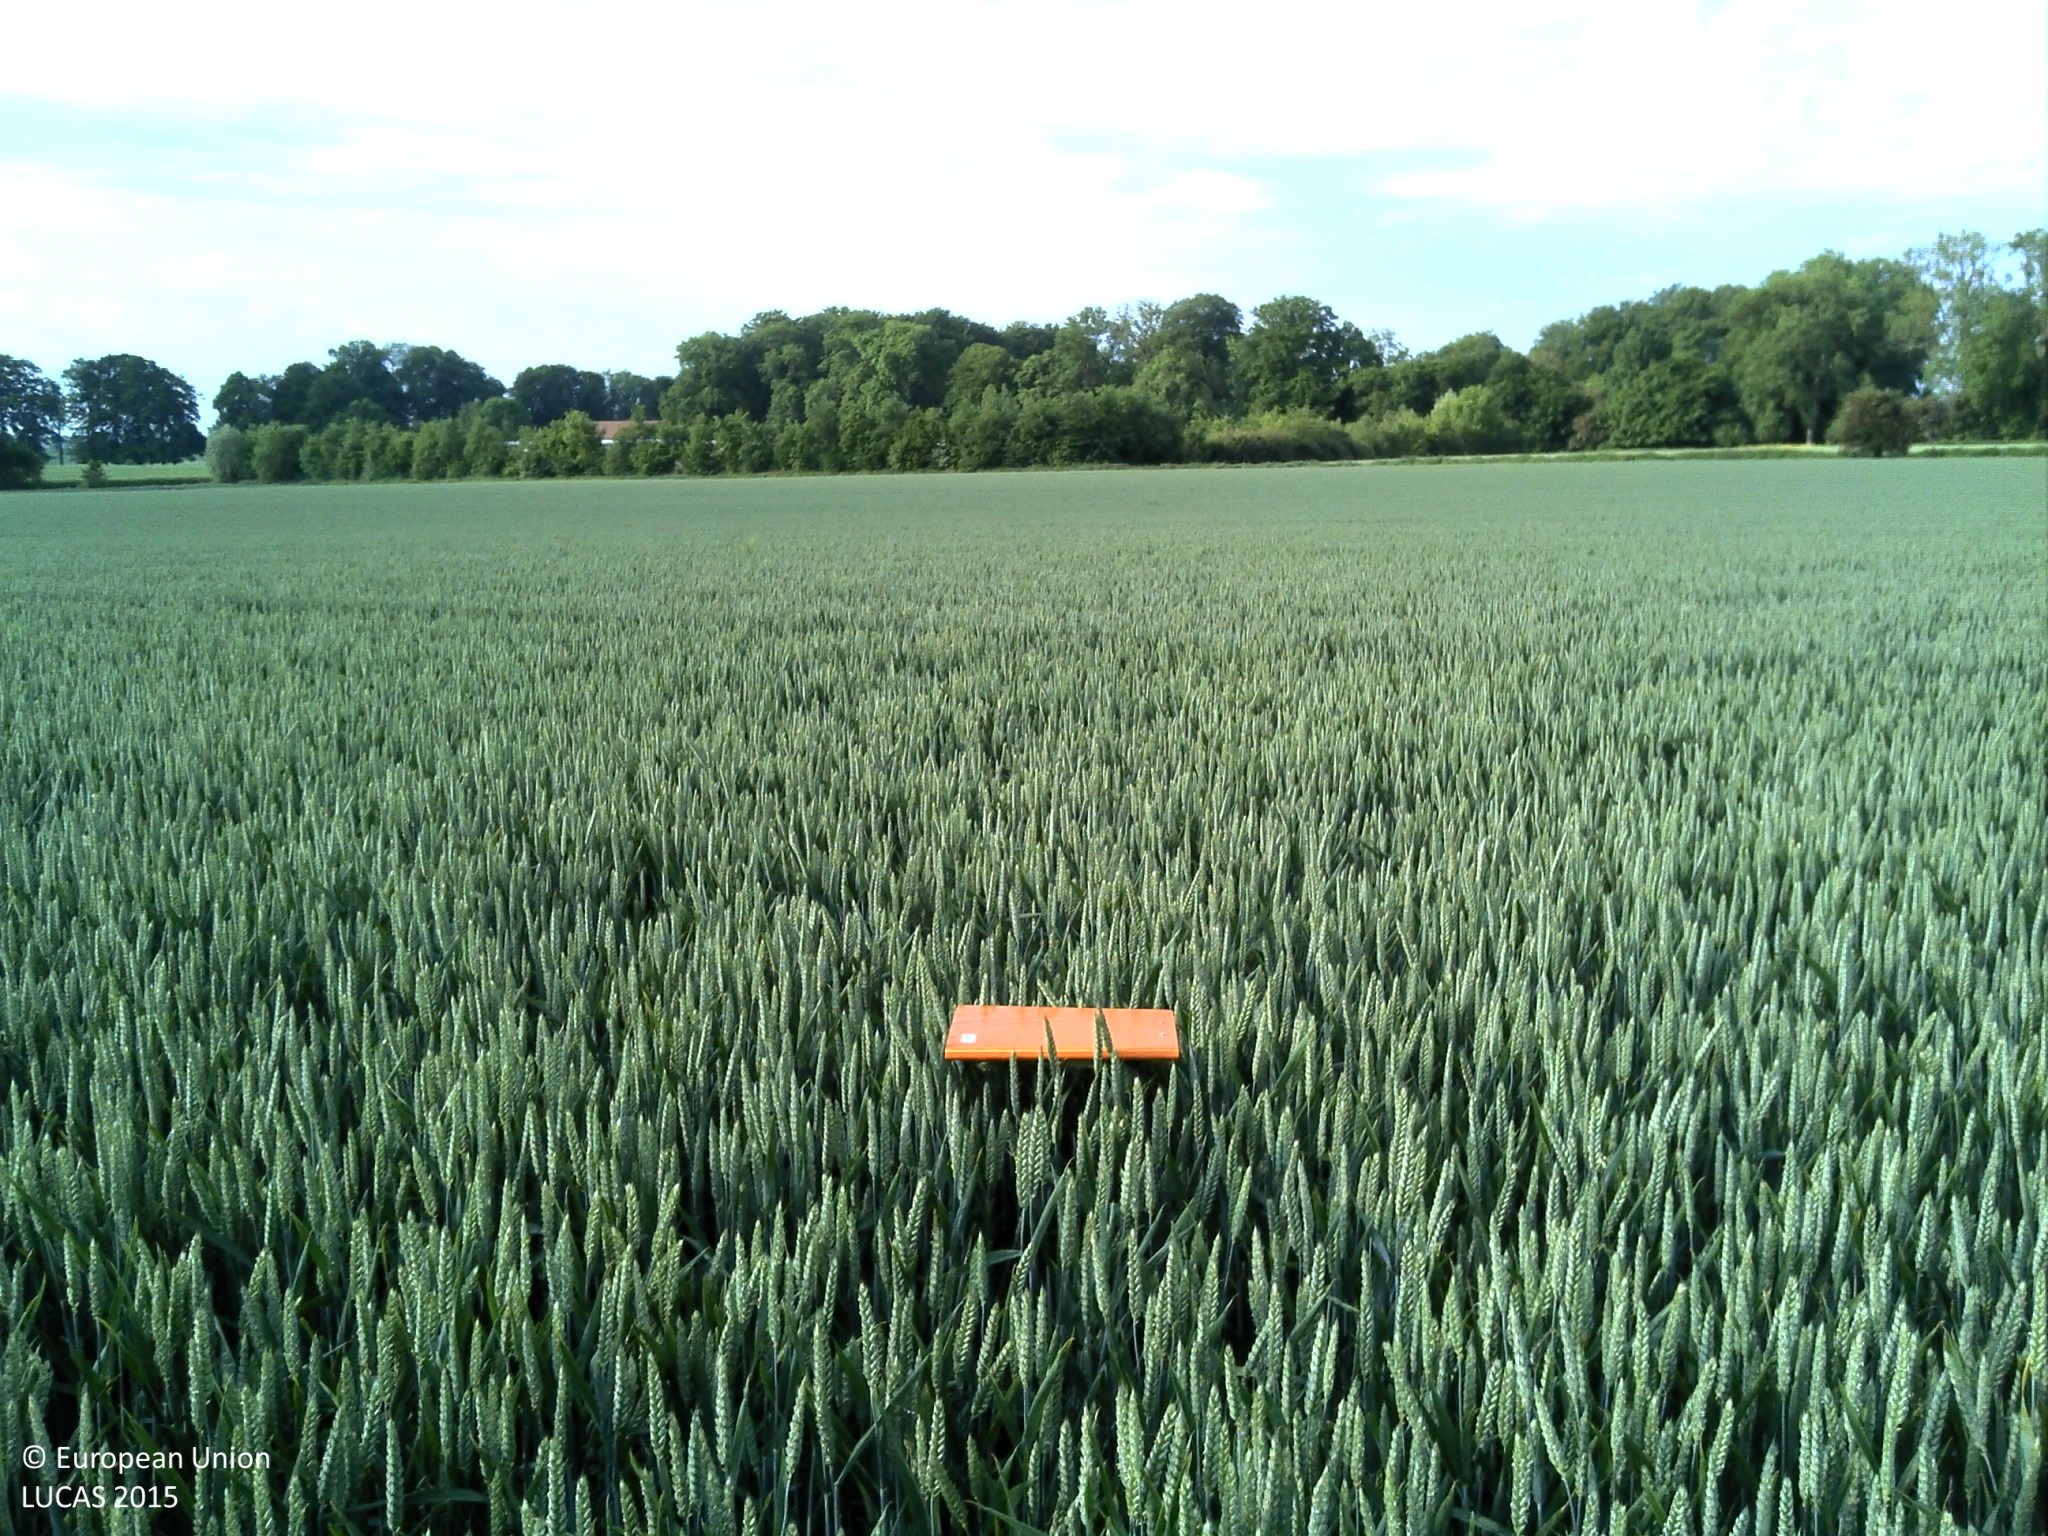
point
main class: Cropland
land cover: Common wheat
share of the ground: > 75 %
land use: Agriculture (excluding fallow land and kitchen gardens)
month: June
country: FR
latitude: 49.6790
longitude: 1.1786
